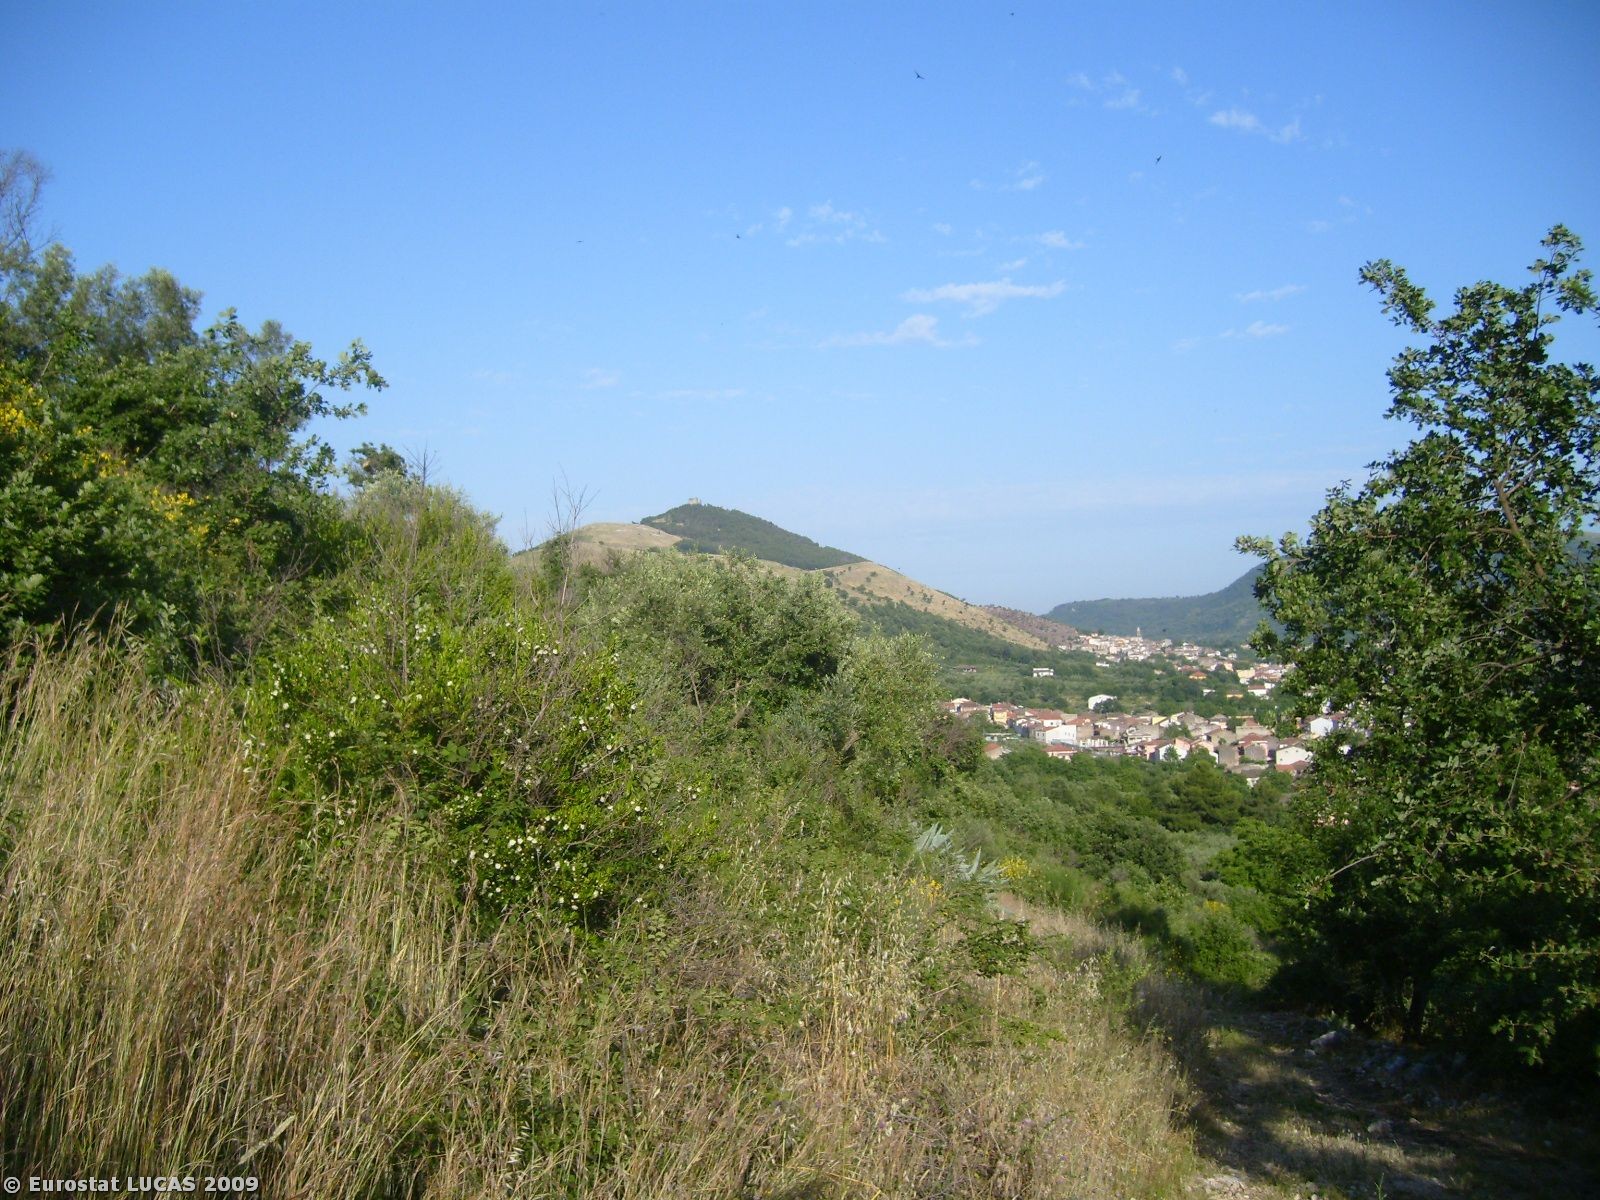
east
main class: Shrubland
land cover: Shrubland with sparse tree cover
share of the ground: > 75 %
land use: Fallow land
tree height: < 5 m
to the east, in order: Shrubland with sparse tree cover
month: June
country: IT
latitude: 41.1319
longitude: 14.3310
